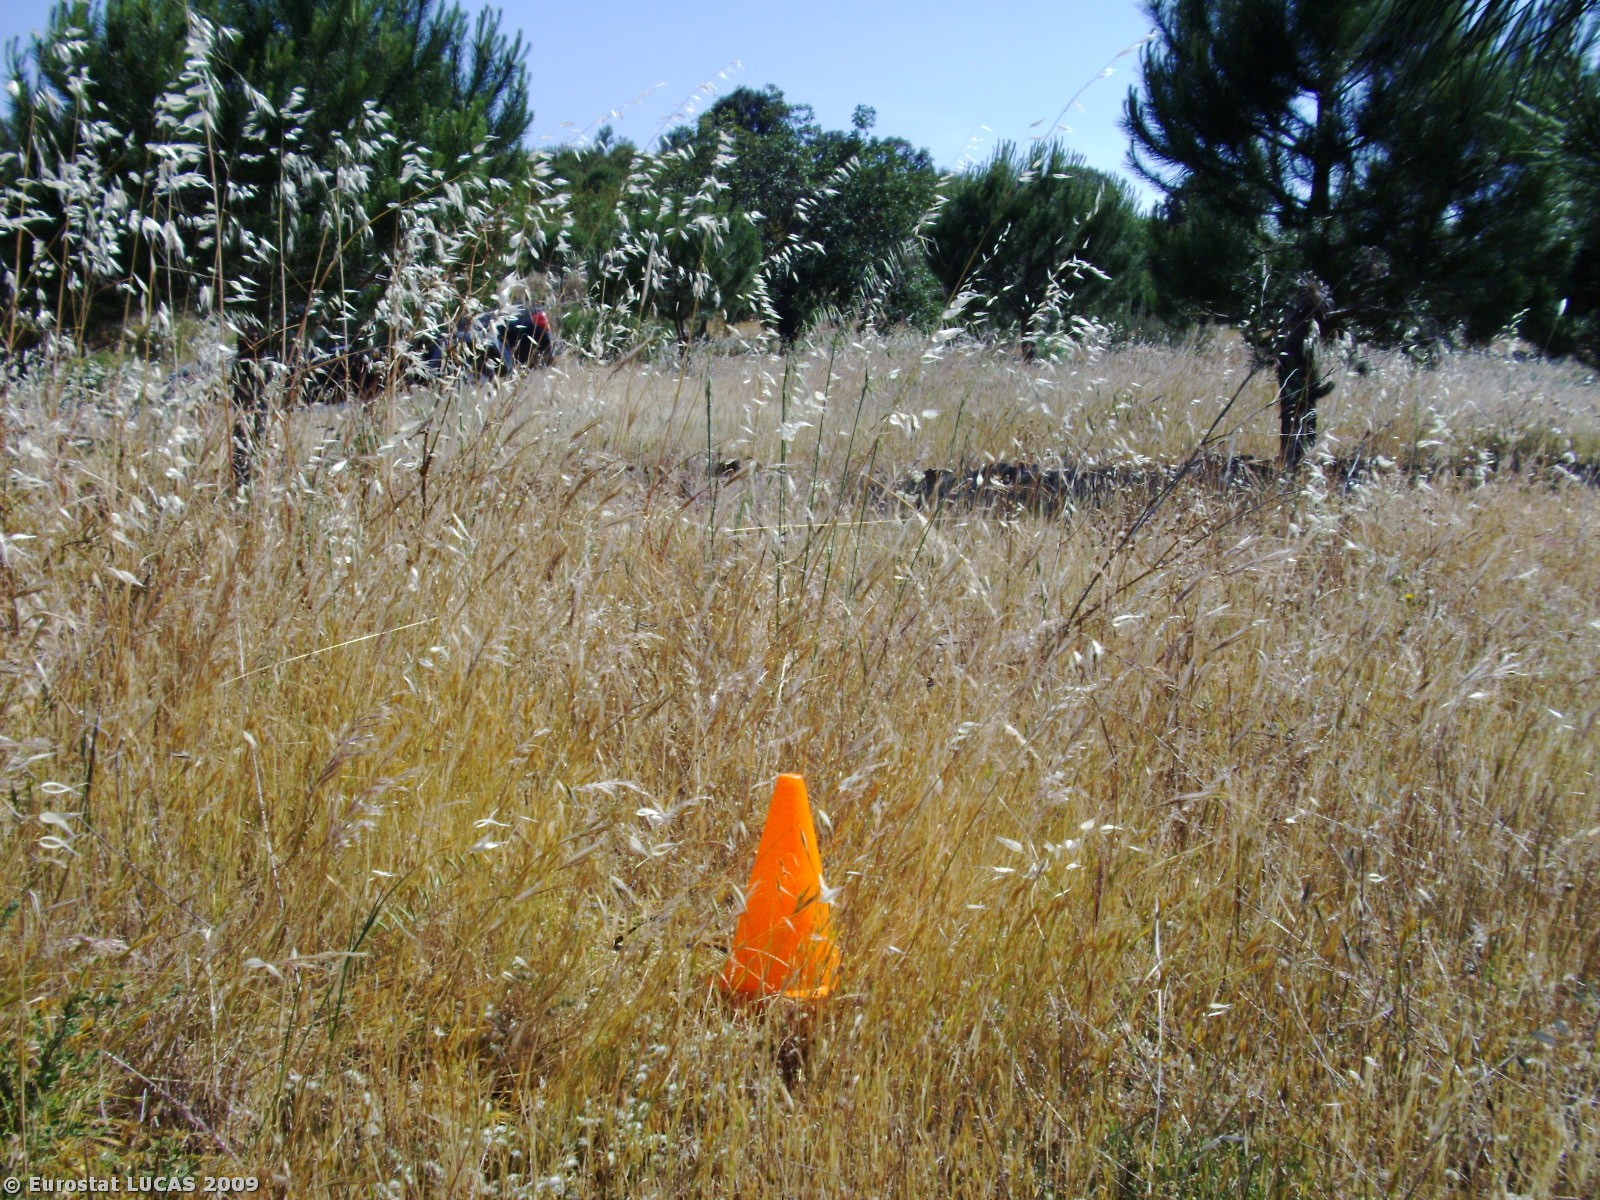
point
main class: Woodland
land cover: Coniferous woodland
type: coniferous forest of the mediterranean region
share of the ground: 10 - 25 %
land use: Forestry
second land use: Unused
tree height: > 5 m
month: May
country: PT
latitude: 37.4439
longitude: -7.4938
